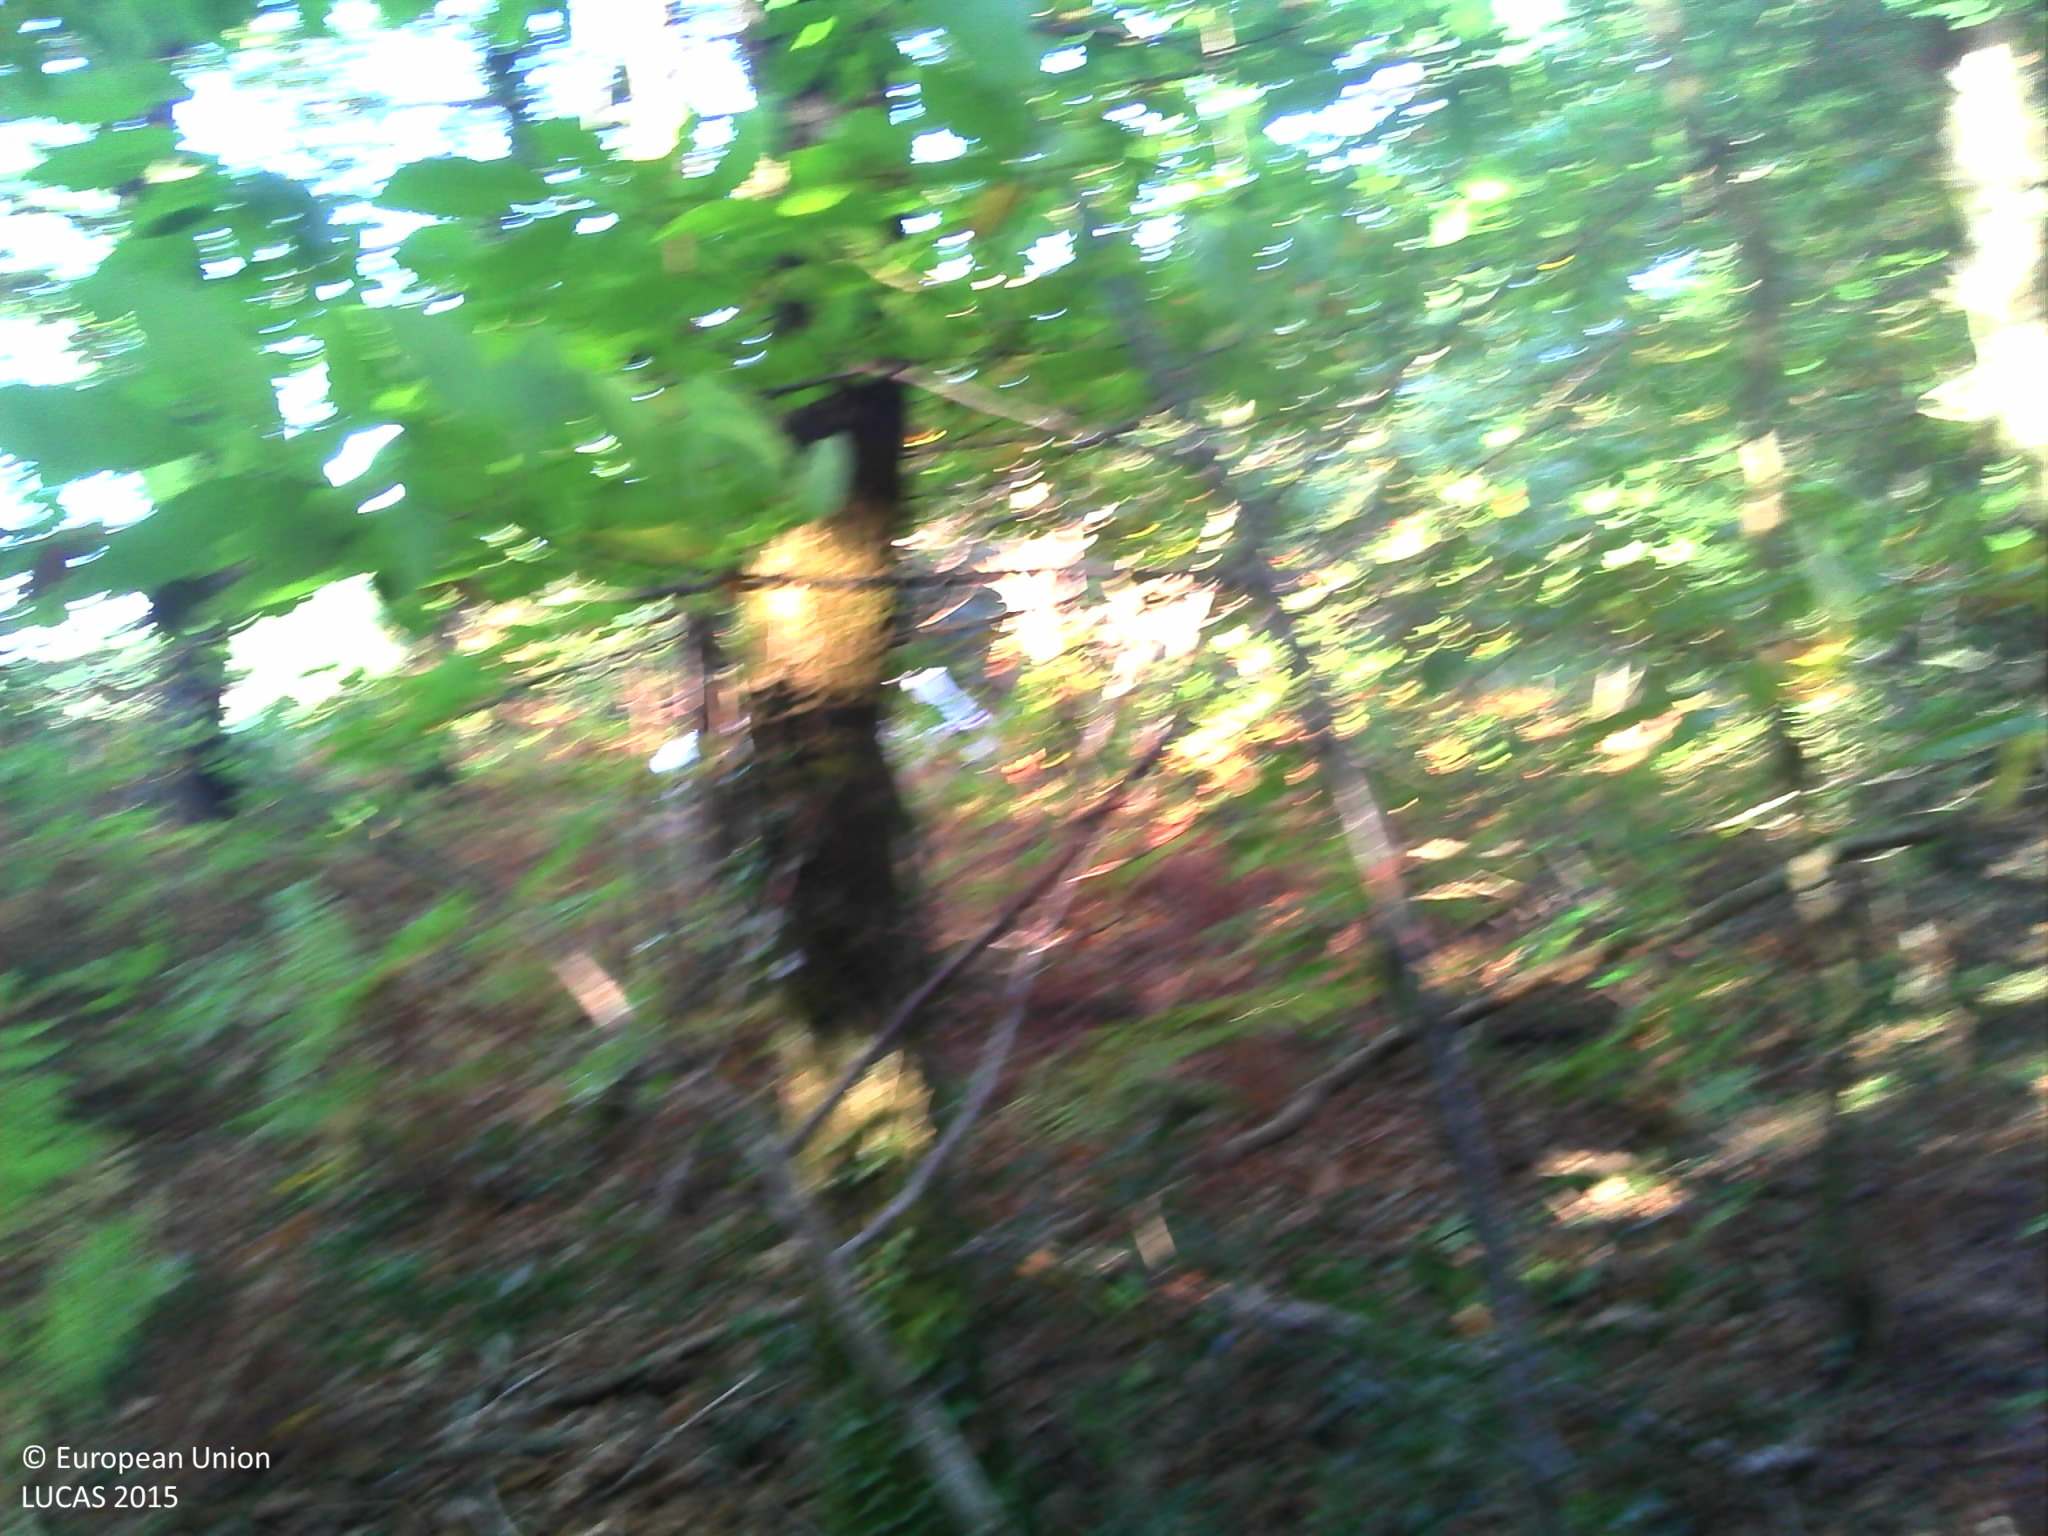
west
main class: Woodland
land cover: Broadleaved woodland
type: acidophilous oak and oak-birch forest
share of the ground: > 75 %
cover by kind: broadleaved forest trees 100 %
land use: Forestry
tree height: > 5 m
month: October
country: FR
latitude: 47.6040
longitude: -2.1432
